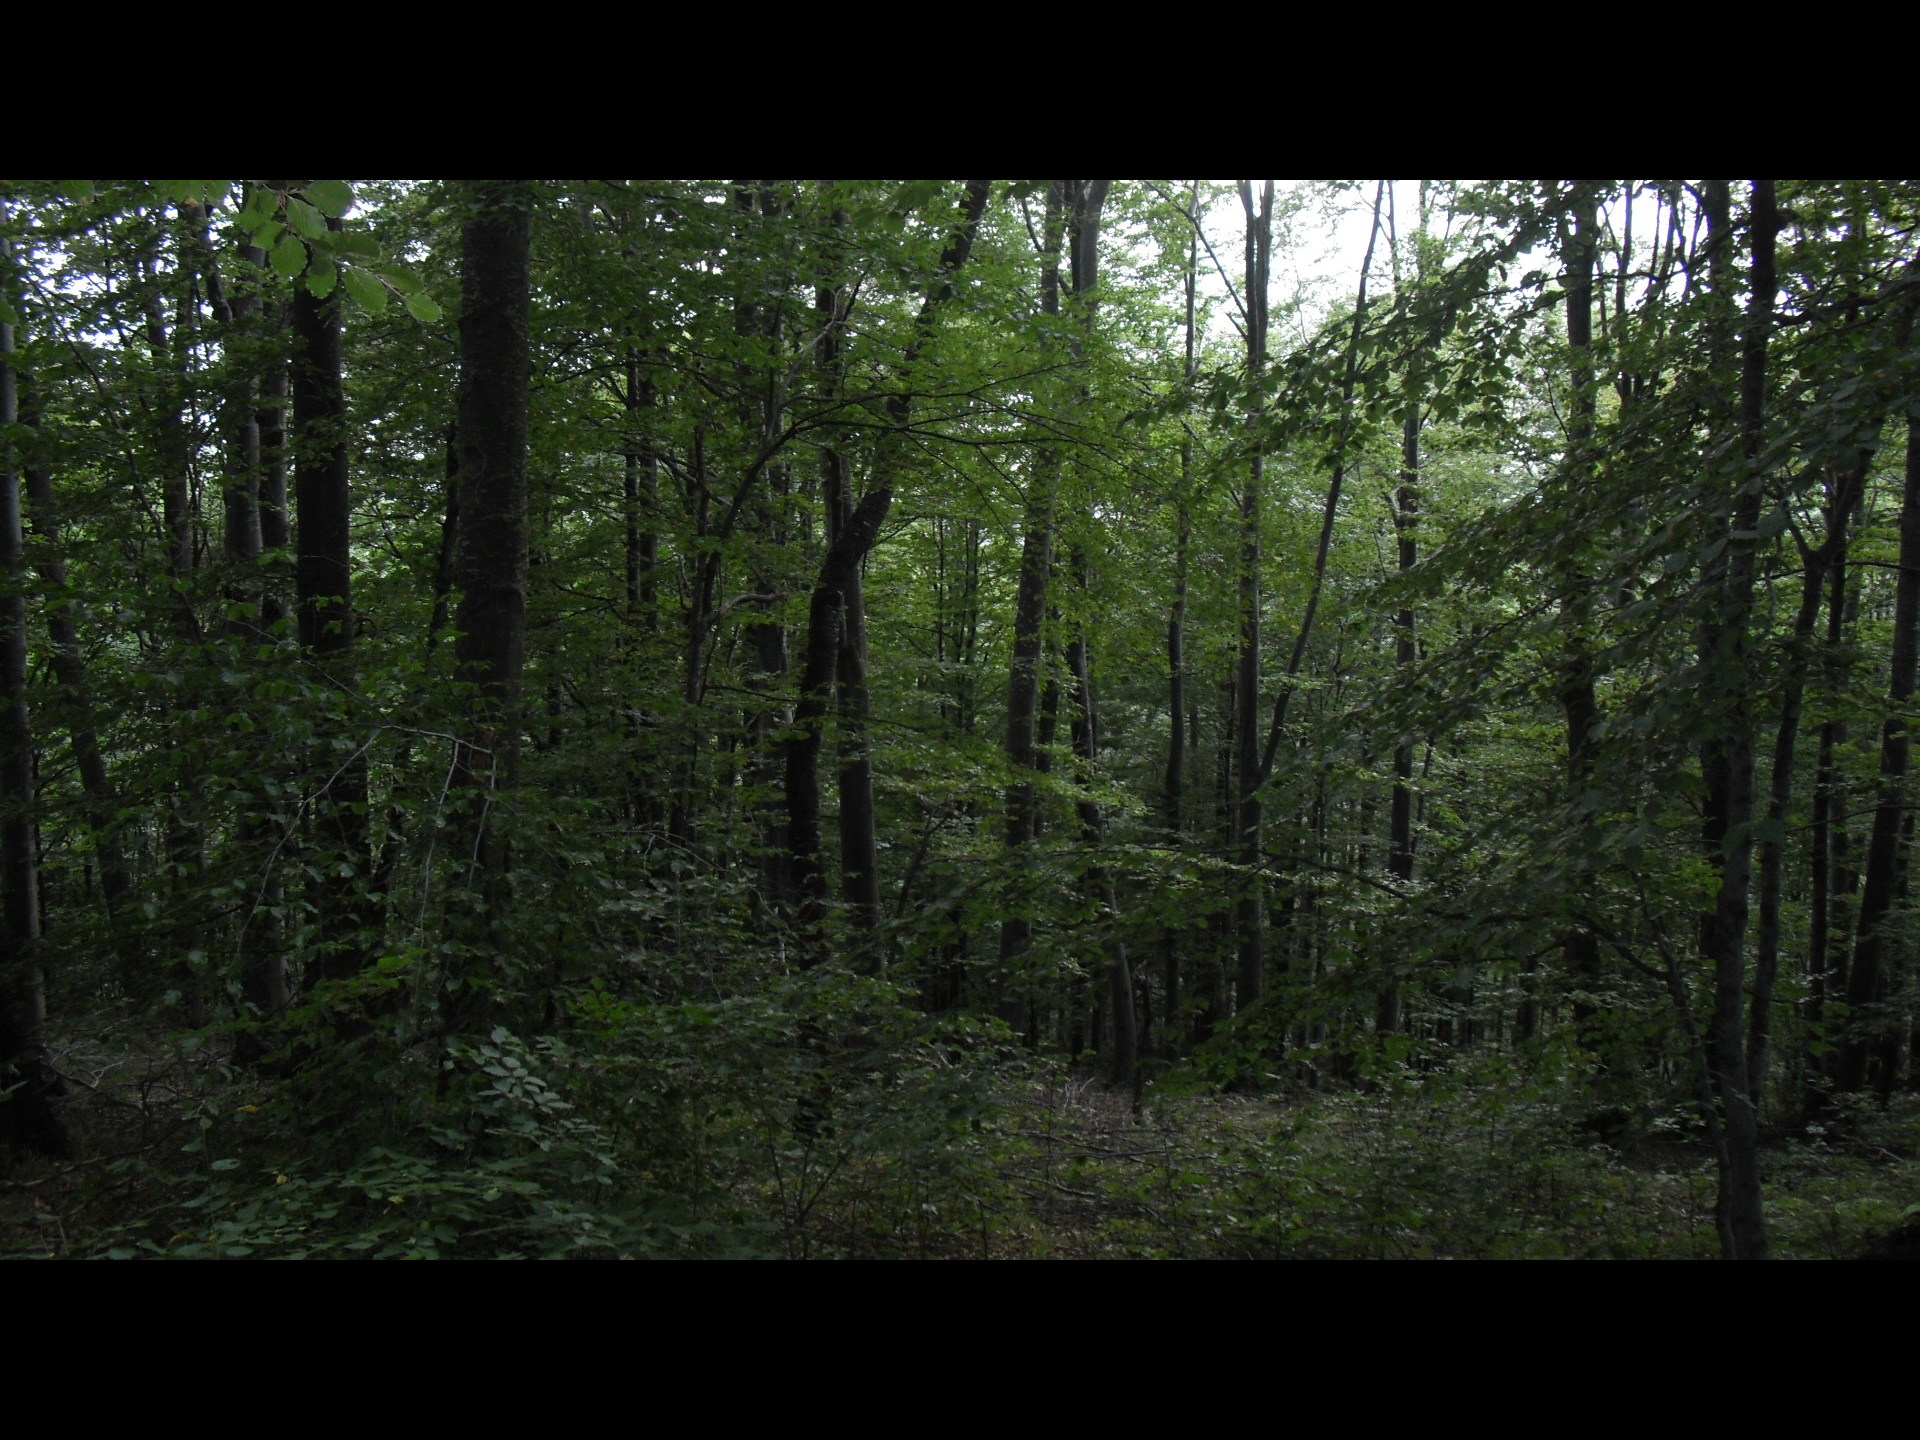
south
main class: Woodland
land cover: Broadleaved woodland
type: beech forest
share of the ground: > 75 %
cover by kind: broadleaved forest trees 95 %, unconsolidated bare surface 5 %
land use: Forestry
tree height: > 5 m
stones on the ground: < 10 %
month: August
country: BG
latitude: 43.2450
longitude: 23.0784
